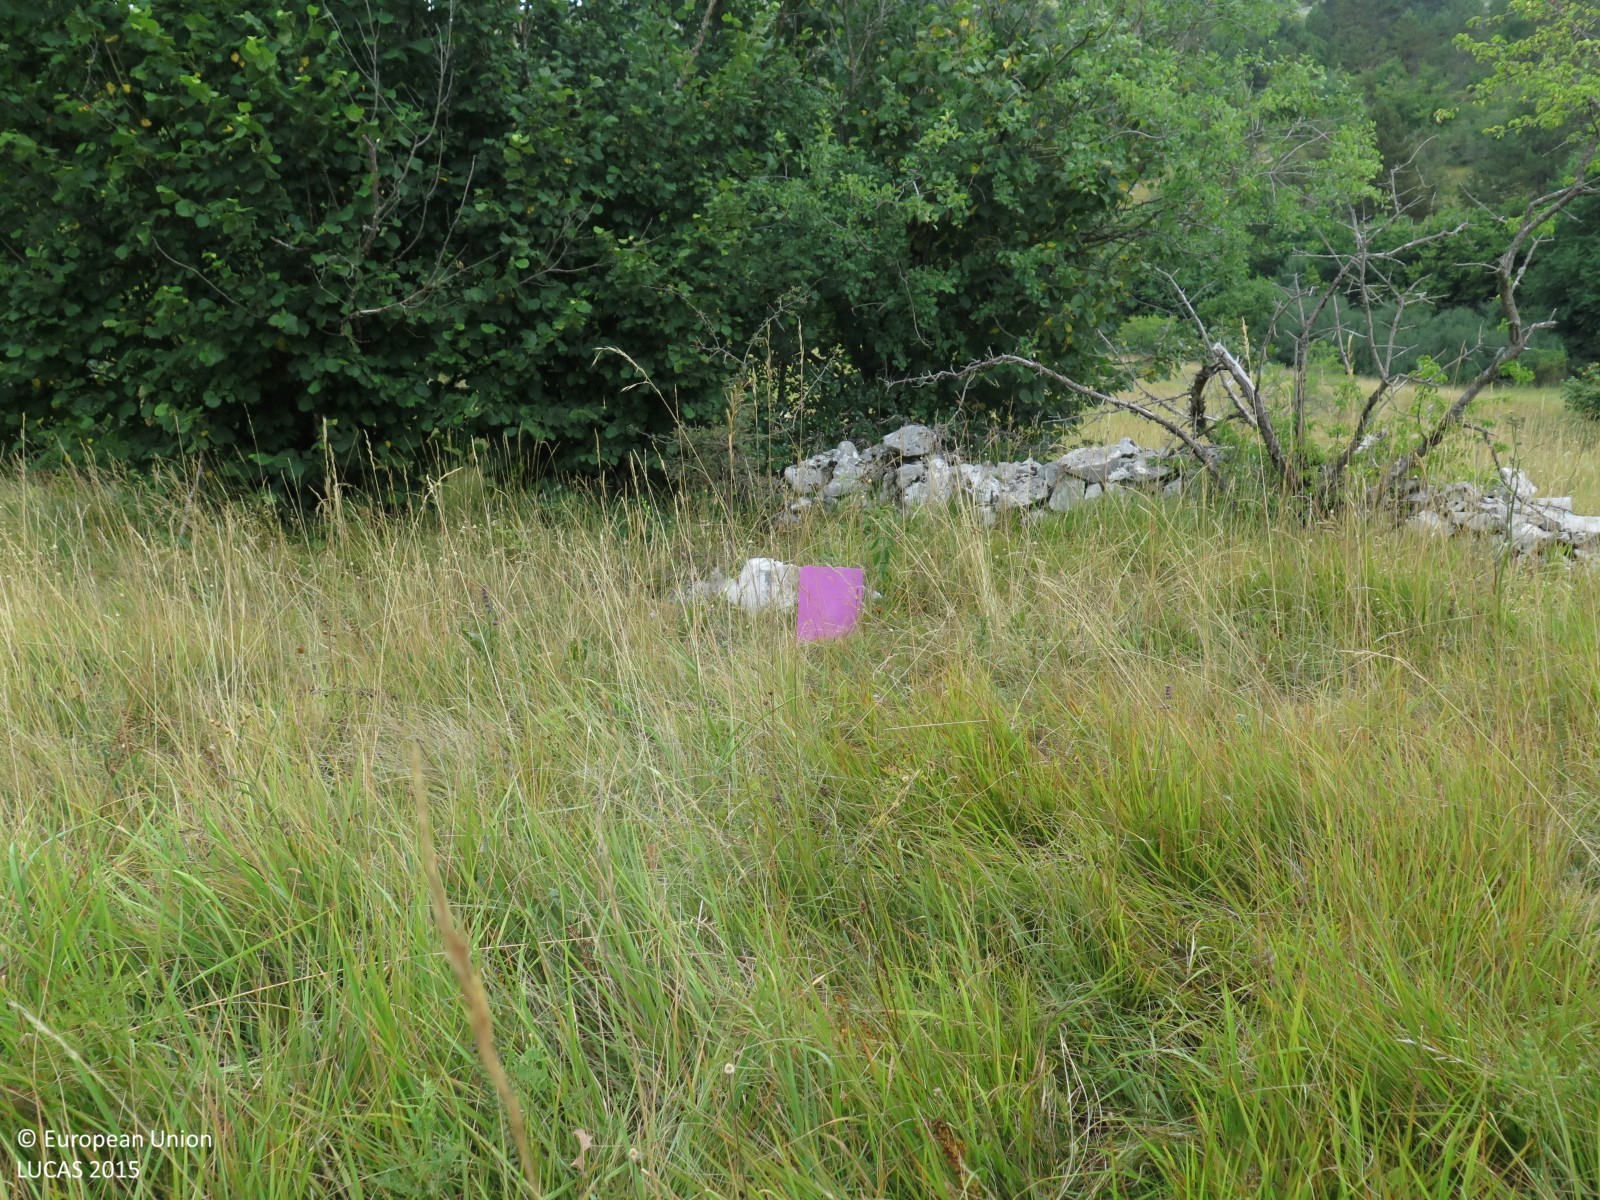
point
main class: Grassland
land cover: Grassland with sparse tree/shrub cover
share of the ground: > 75 %
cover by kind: herbaceous plants 90 %, broadleaved forest trees 5 %, shrubs 5 %
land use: Abandoned areas
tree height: < 5 m
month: July
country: HR
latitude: 45.4439
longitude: 14.0736
